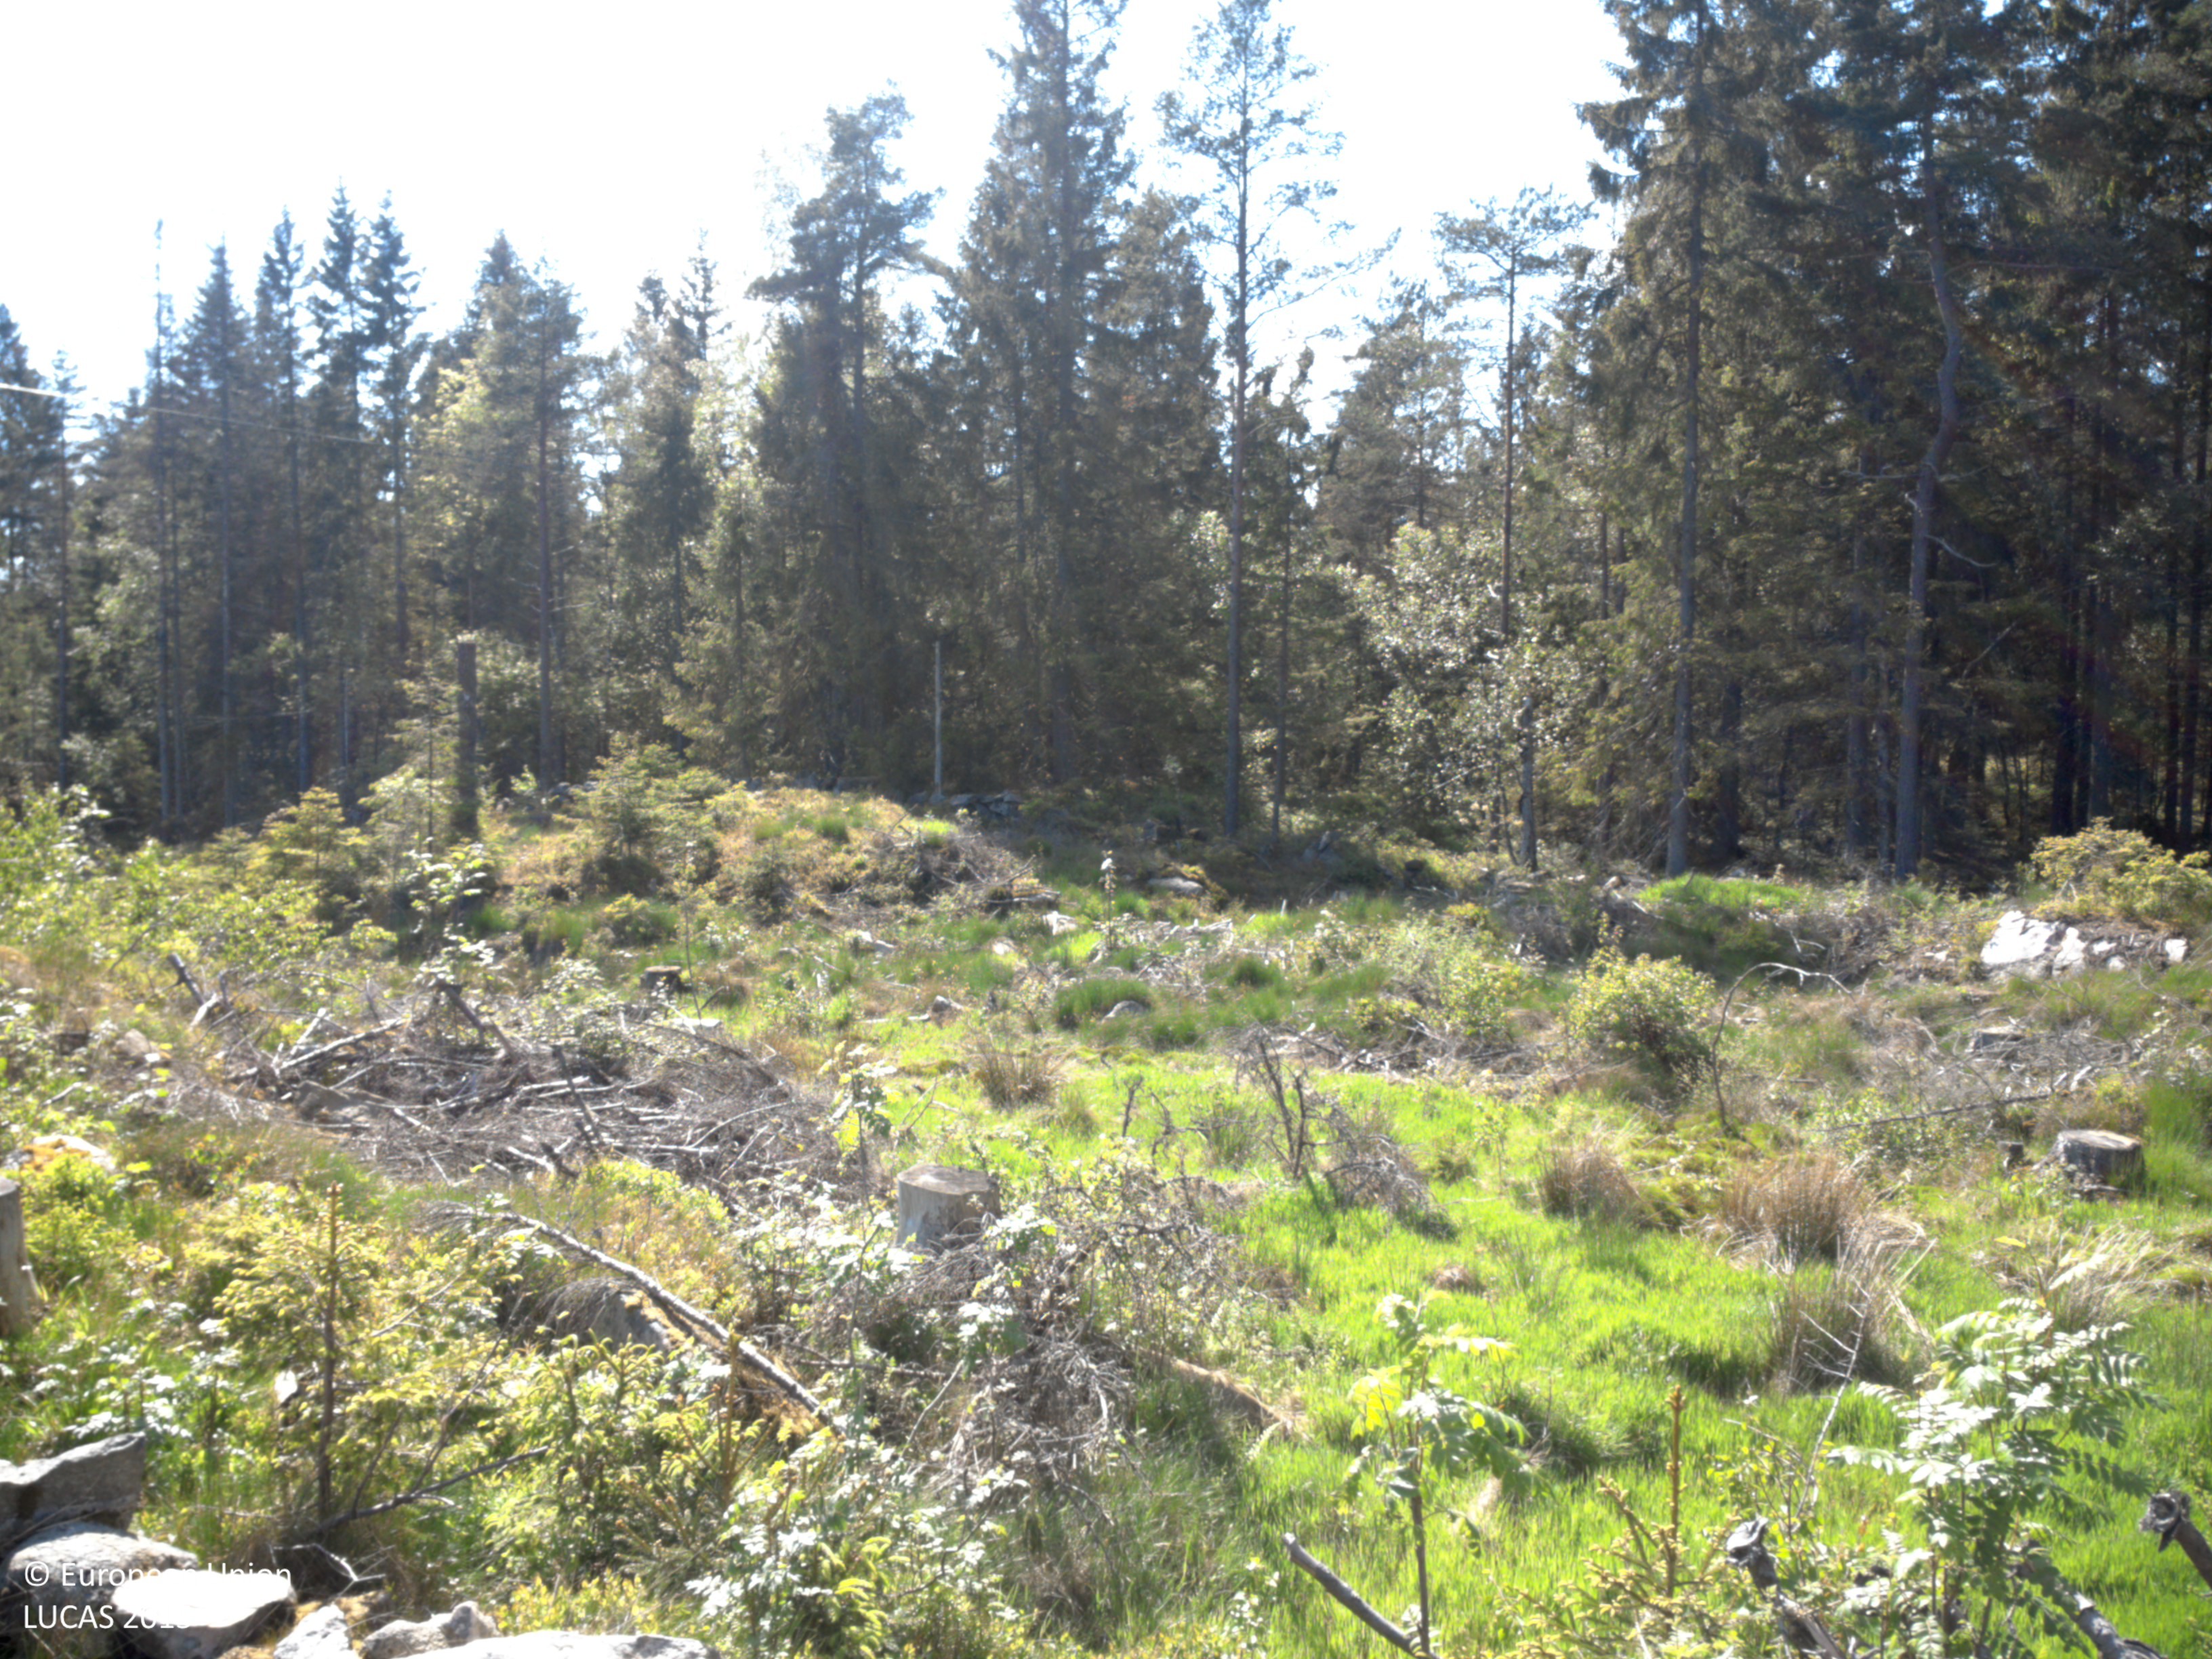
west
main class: Grassland
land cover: Grassland with sparse tree/shrub cover
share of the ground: > 75 %
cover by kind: herbaceous plants 70 %, coniferous forest trees 5 %
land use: Forestry
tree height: > 5 m
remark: Clear cut
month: June
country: SE
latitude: 58.3856
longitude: 11.9288
